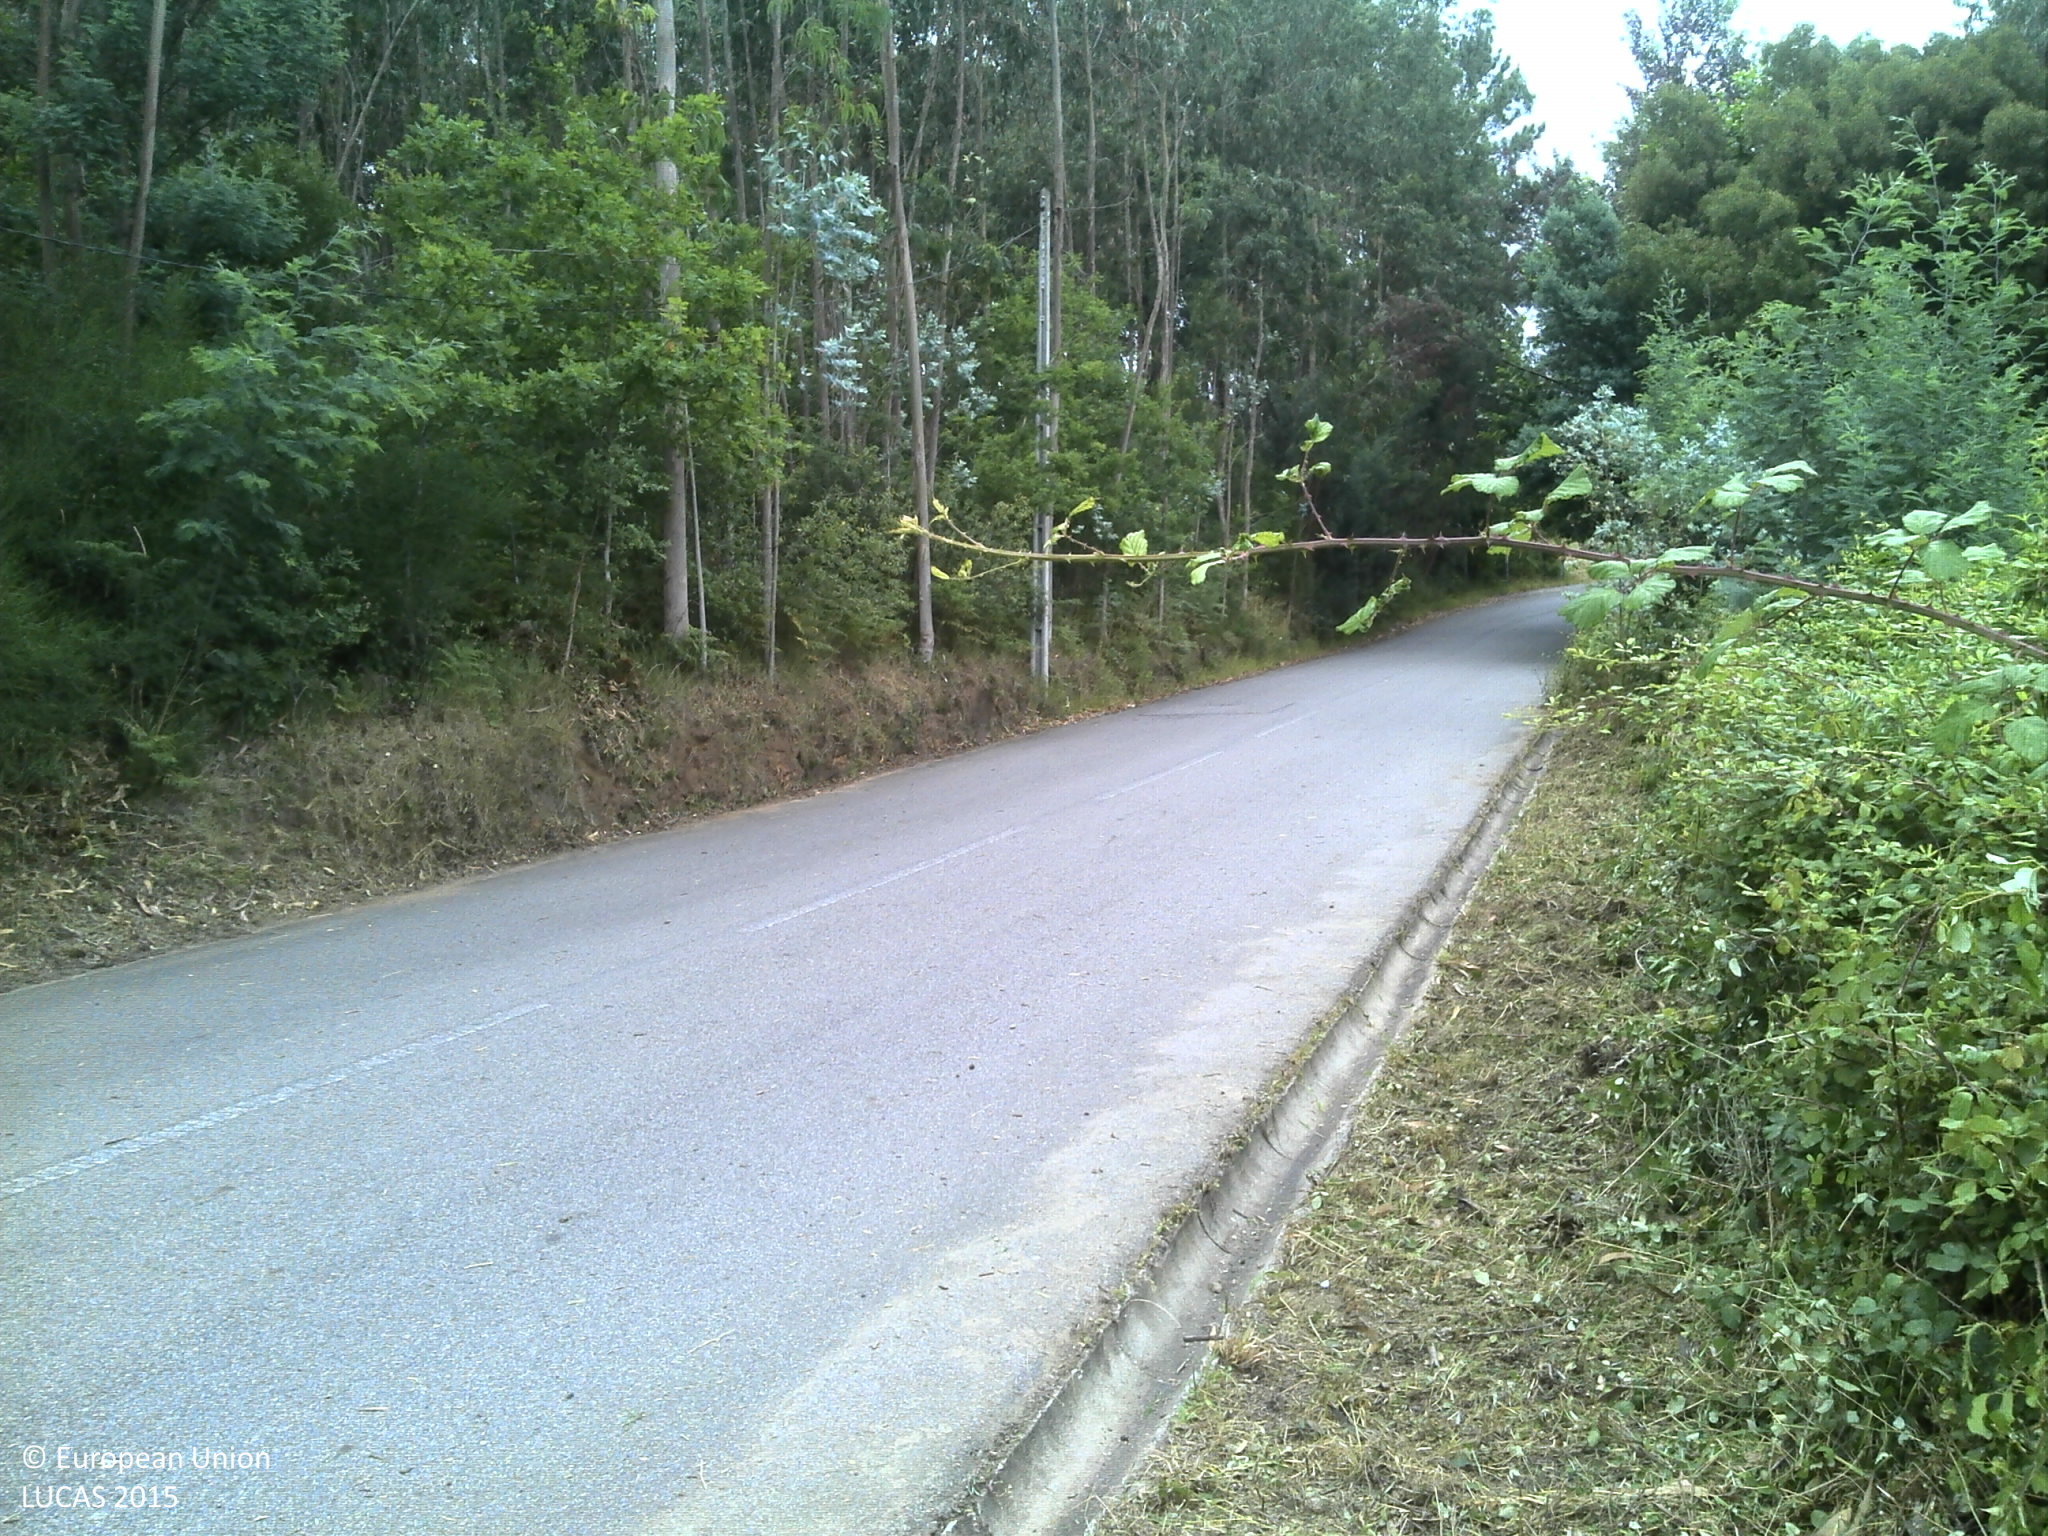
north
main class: Shrubland
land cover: Shrubland without tree cover
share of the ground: > 75 %
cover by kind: shrubs 90 %, unconsolidated bare surface 10 %
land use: Forestry
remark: Clear cut
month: June
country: PT
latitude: 40.7539
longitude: -8.4649
